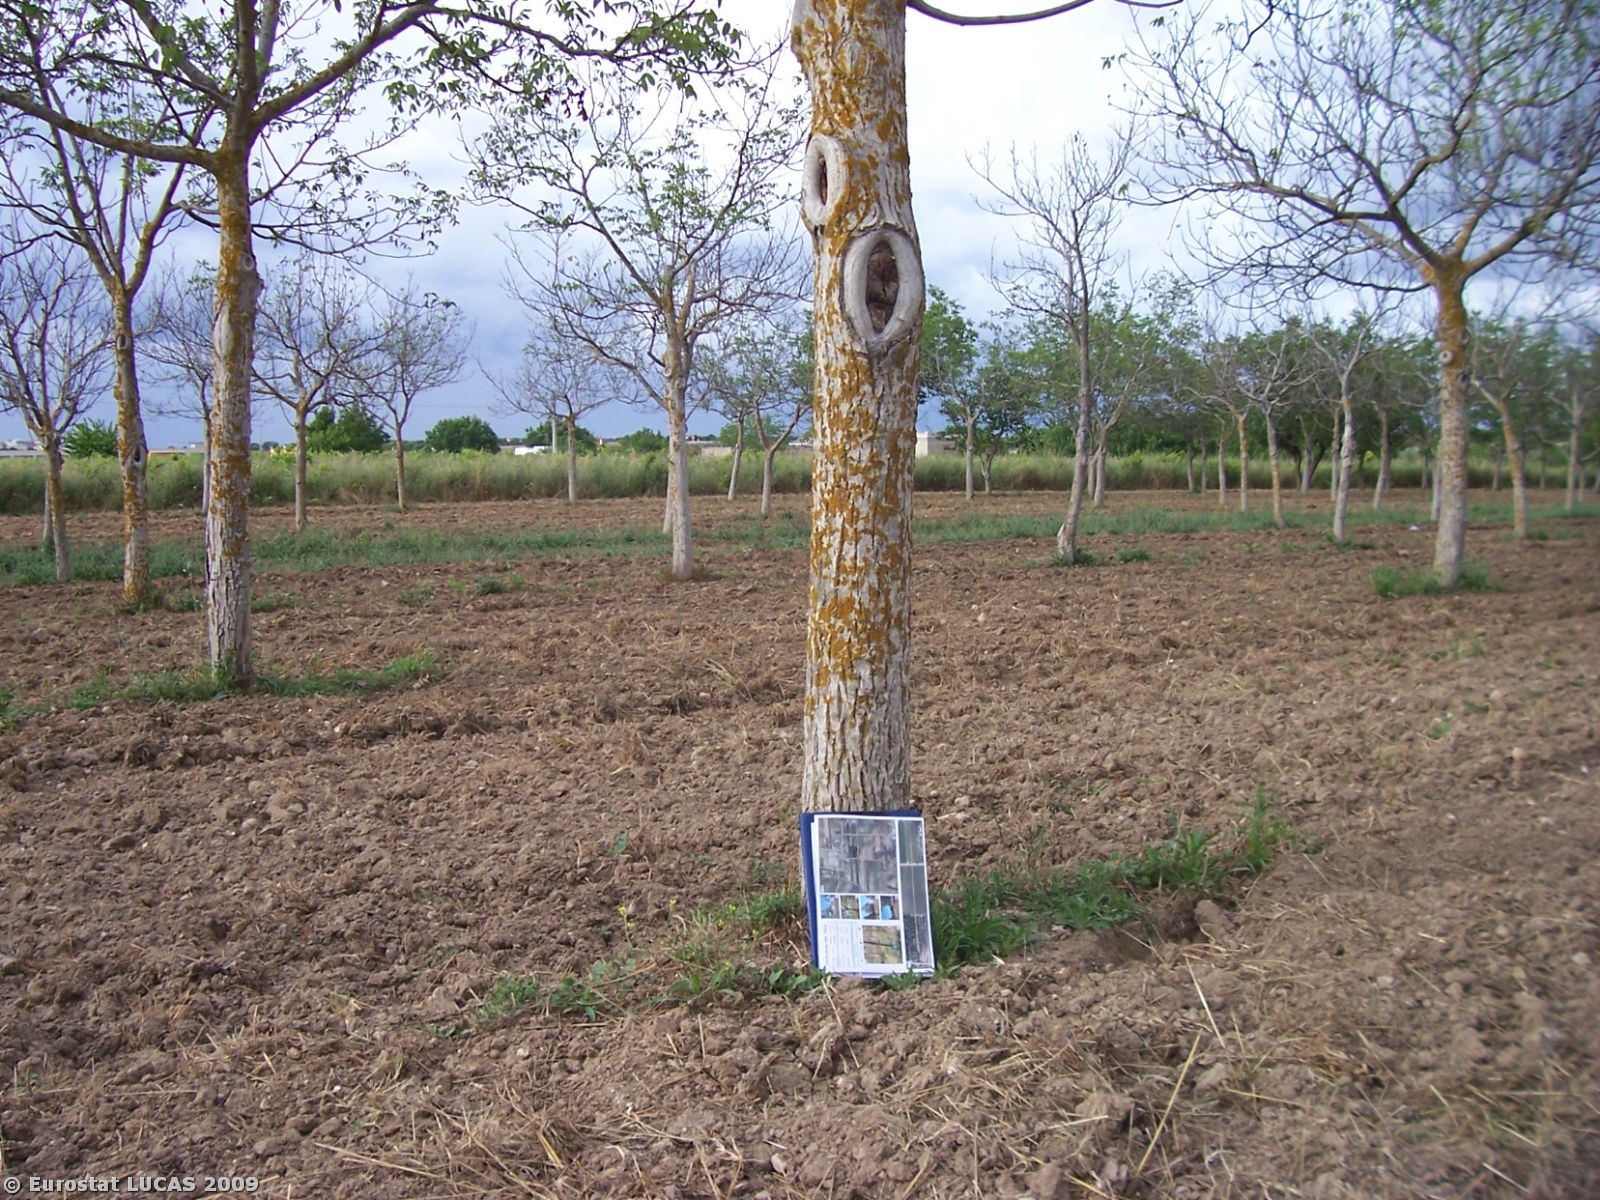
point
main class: Cropland
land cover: Nuts trees
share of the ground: 50 - 75 %
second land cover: Bare land
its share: > 75 %
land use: Agriculture (excluding fallow land and kitchen gardens)
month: June
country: IT
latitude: 40.4335
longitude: 17.5080
